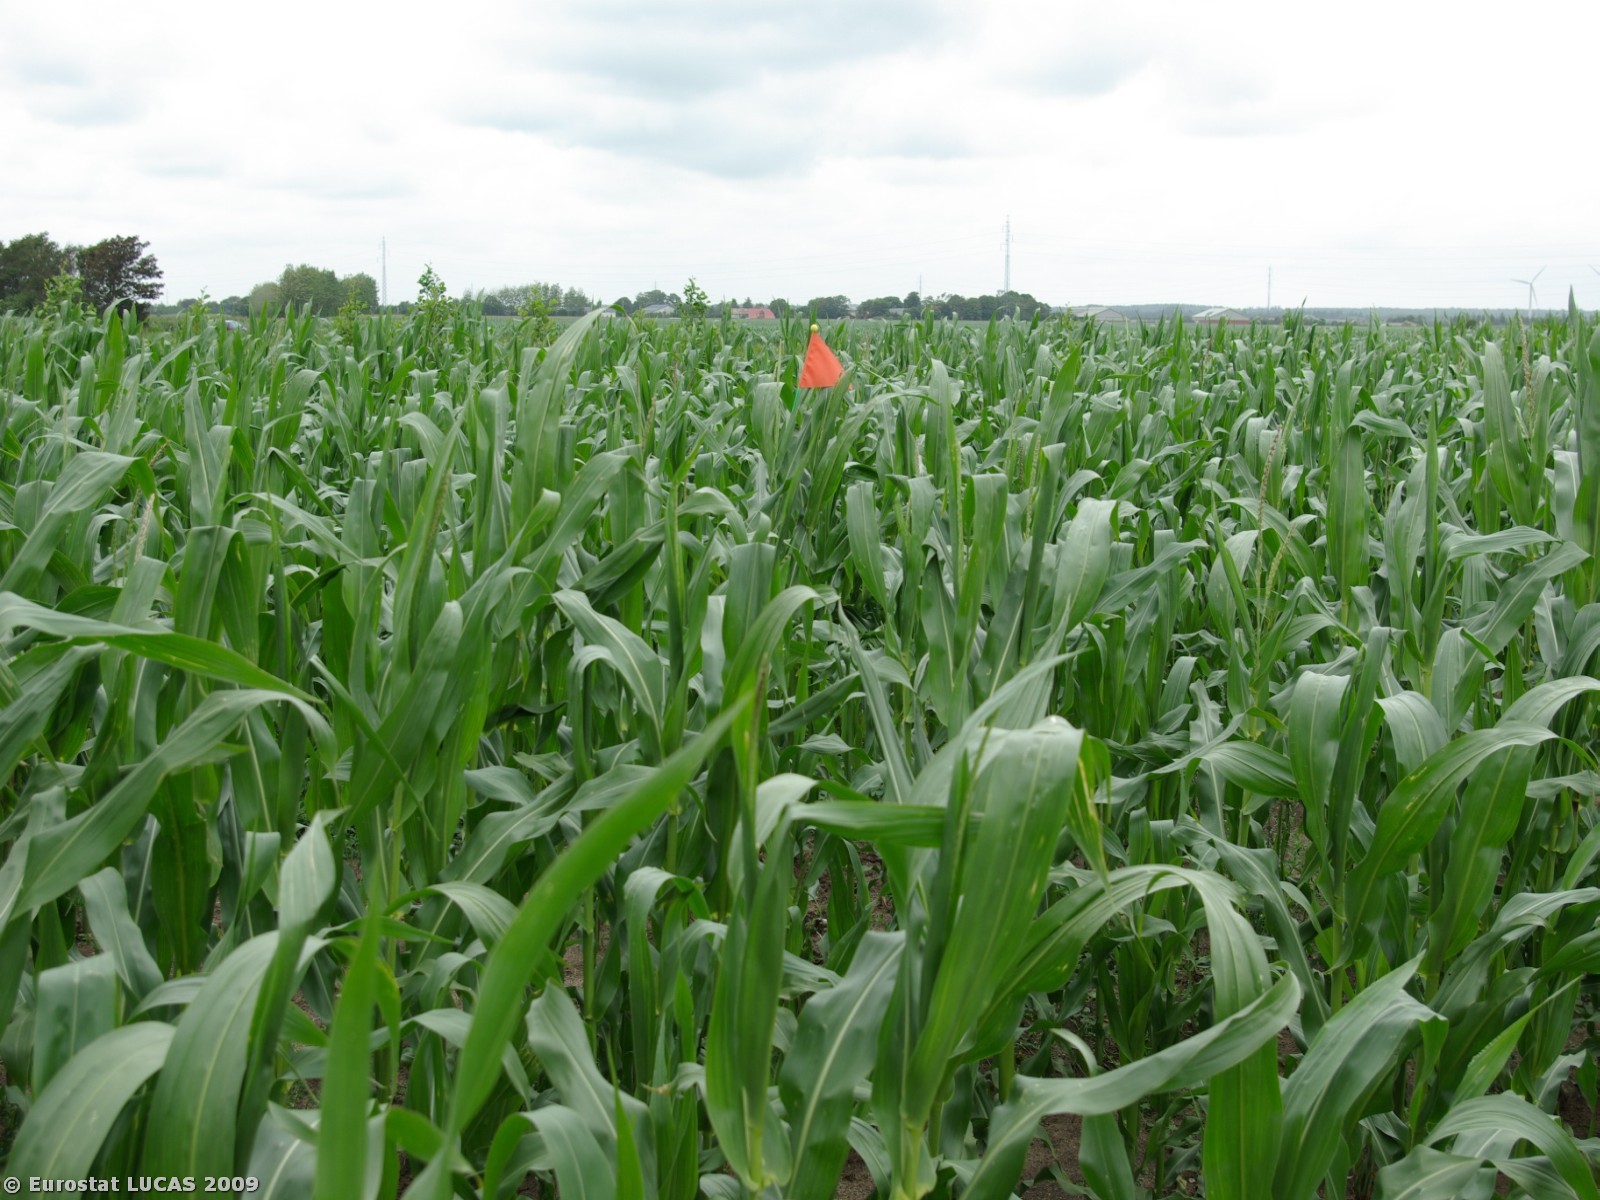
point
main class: Cropland
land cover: Maize
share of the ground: 50 - 75 %
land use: Agriculture (excluding fallow land and kitchen gardens)
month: July
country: DK
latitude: 55.0858
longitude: 8.8259
